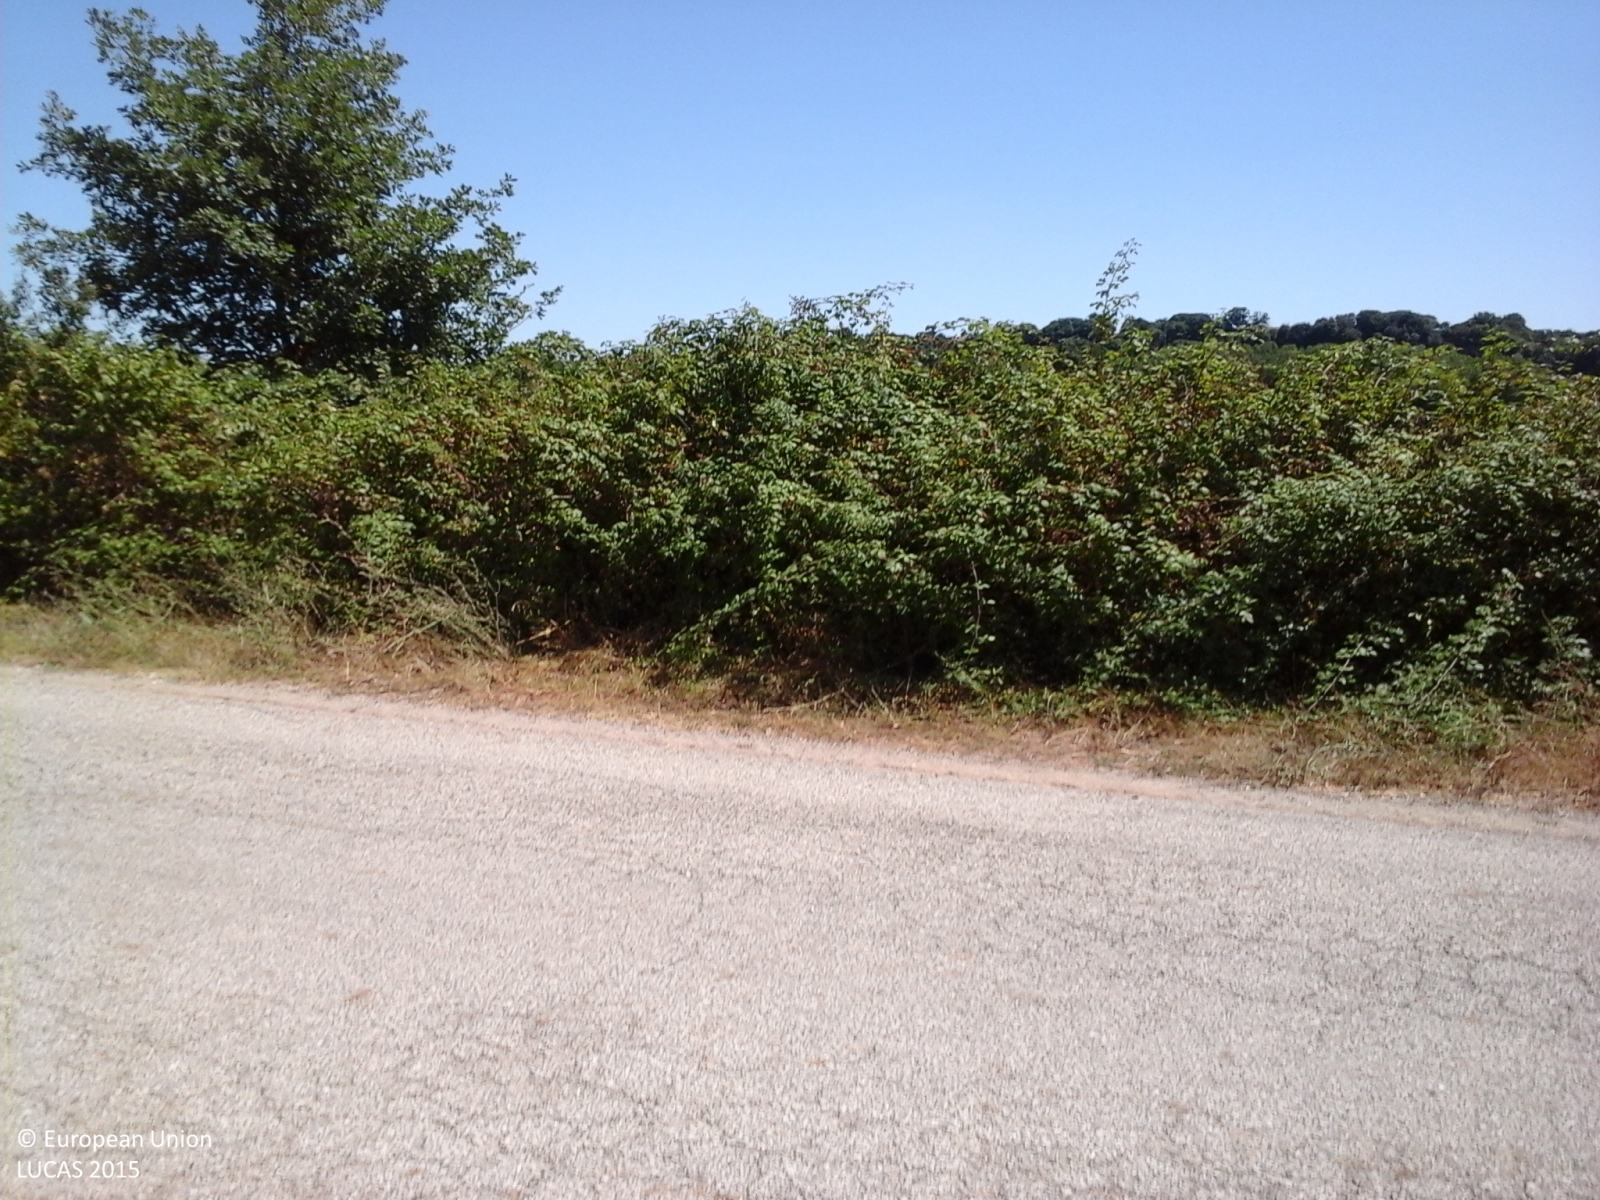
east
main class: Cropland
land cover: Temporary grasslands
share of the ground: > 75 %
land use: Agriculture (excluding fallow land and kitchen gardens)
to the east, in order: Temporary grasslands; Fences; Grass margins; Paved roads, cycling and walking lanes; Grass margins; Abandoned hedges; Grassland without tree/shrub cover; Fences; Temporary grasslands; Grassland without tree/shrub cover; Single bushes/trees; Grassland without tree/shrub cover
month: August
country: IT
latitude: 42.6415
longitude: 11.5924
